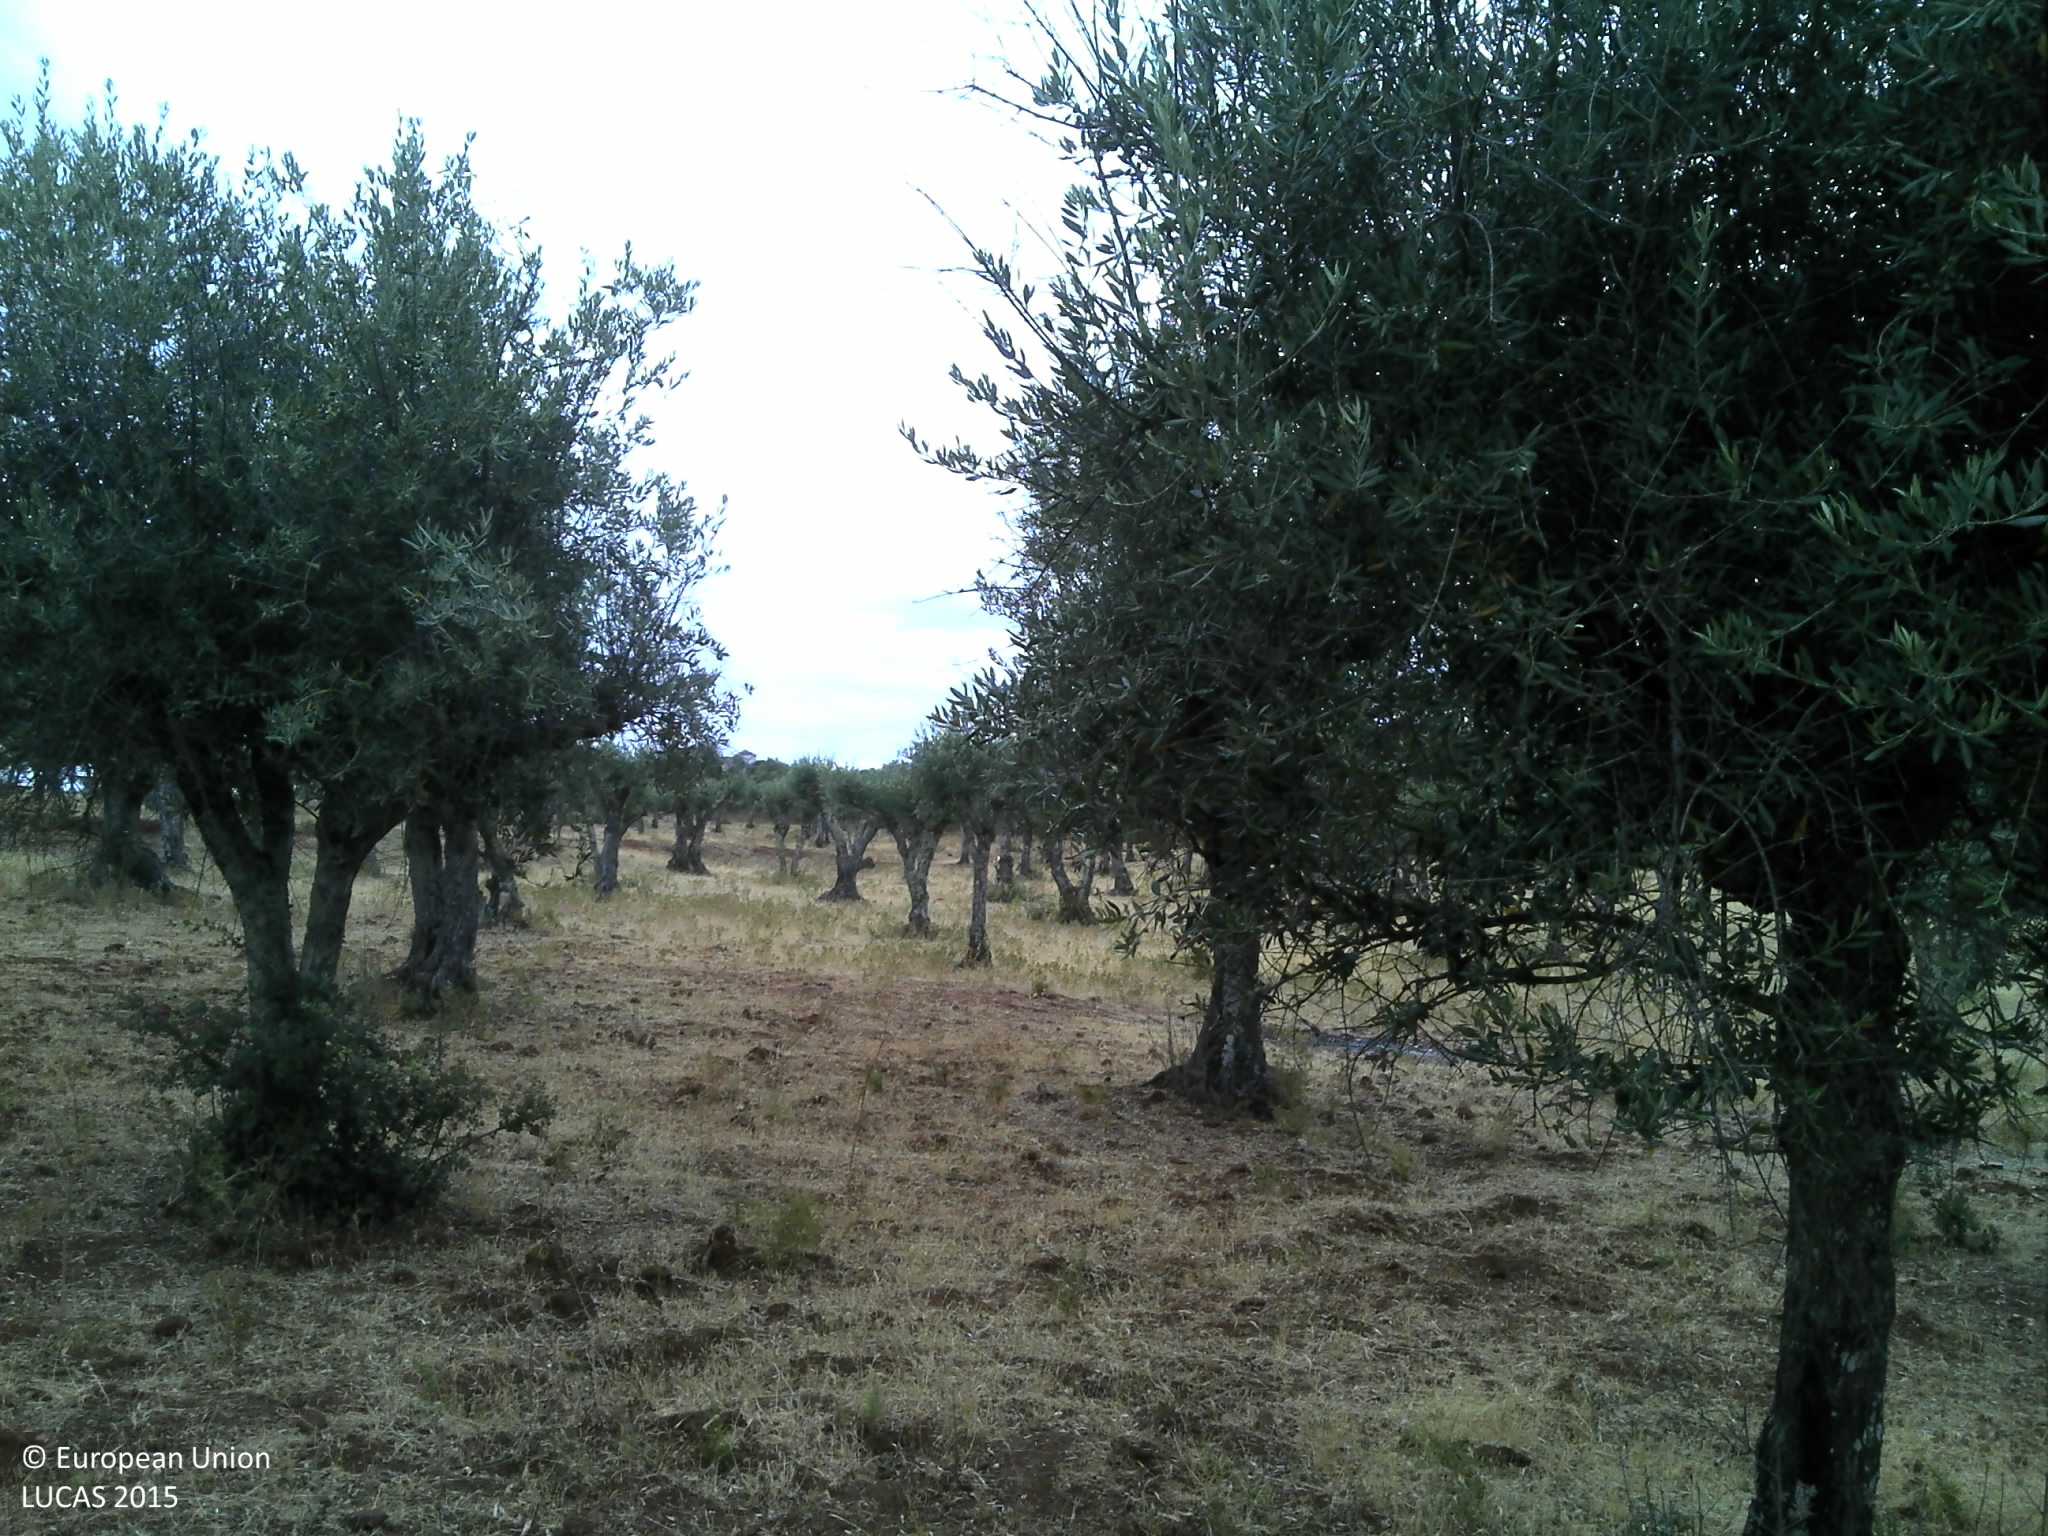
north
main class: Cropland
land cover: Olive groves
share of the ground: 25 - 50 %
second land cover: Grassland without tree/shrub cover
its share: 25 - 50 %
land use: Agriculture (excluding fallow land and kitchen gardens)
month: July
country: PT
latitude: 38.7915
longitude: -7.4991
